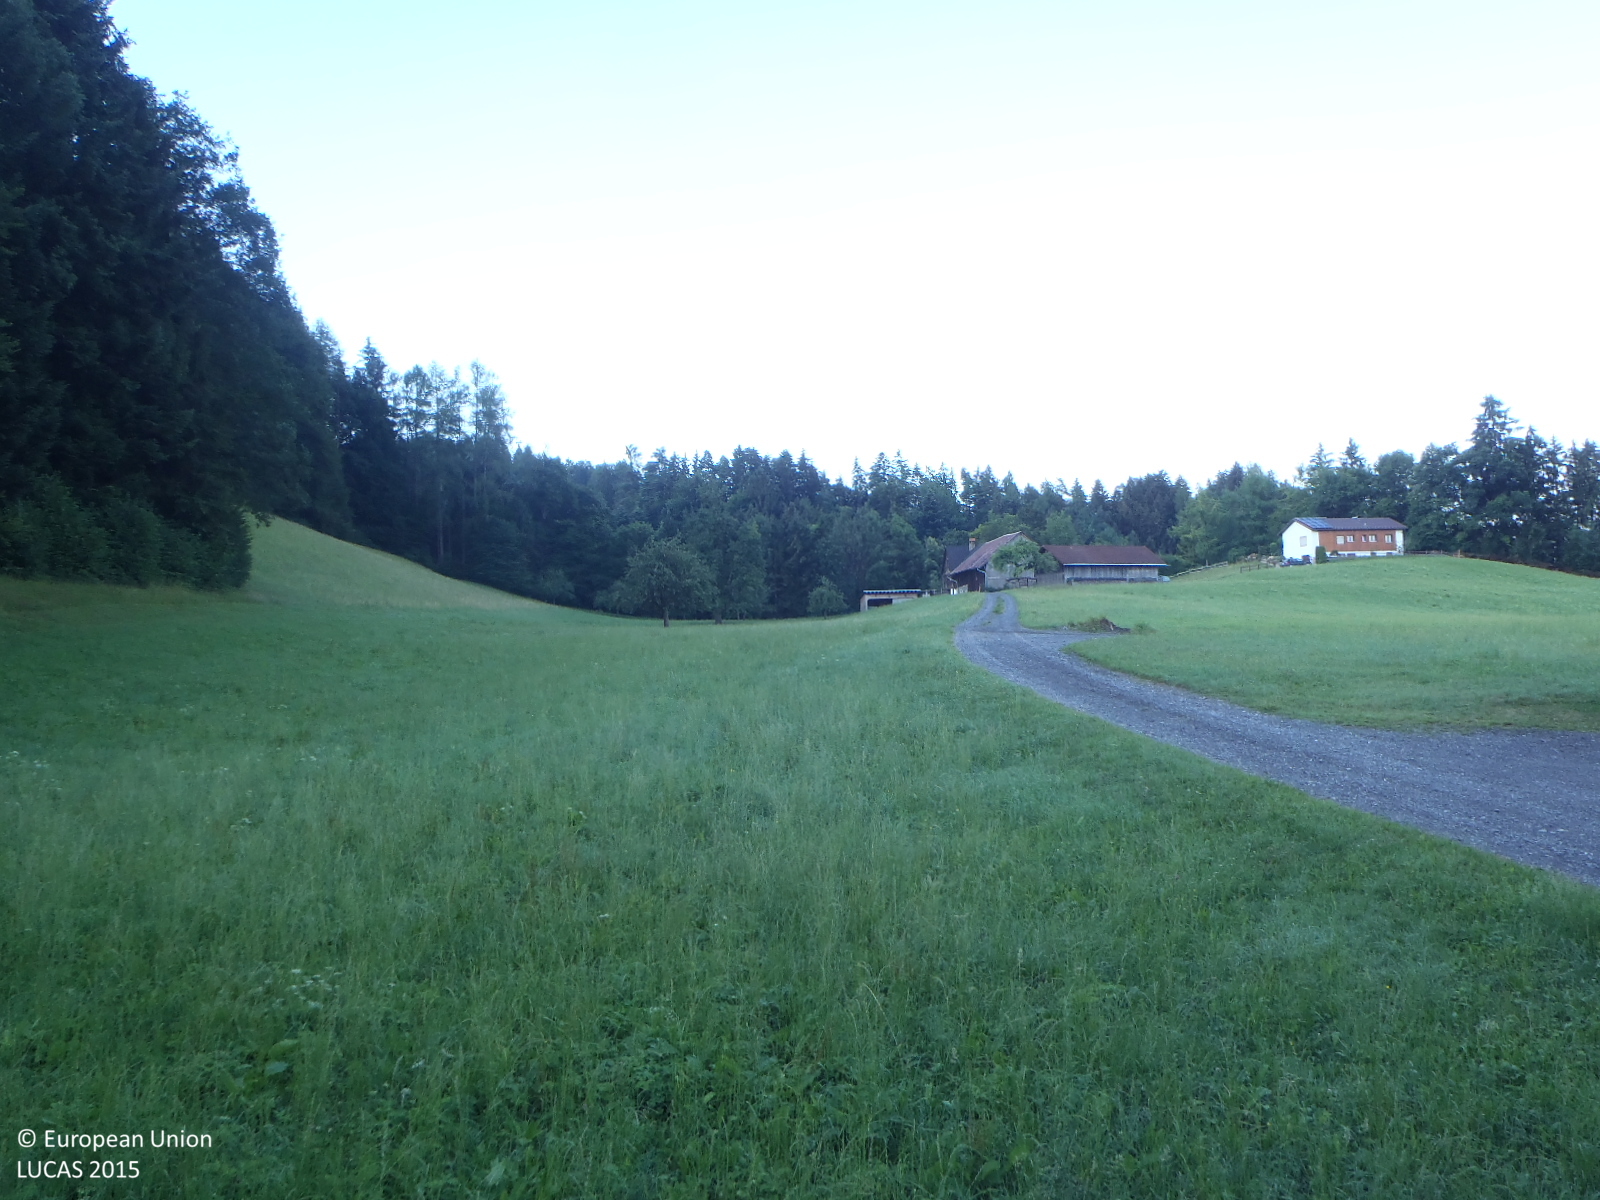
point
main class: Grassland
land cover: Grassland without tree/shrub cover
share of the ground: > 75 %
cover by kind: herbaceous plants 100 %
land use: Agriculture (excluding fallow land and kitchen gardens)
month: July
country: AT
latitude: 47.2871
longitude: 9.6698
